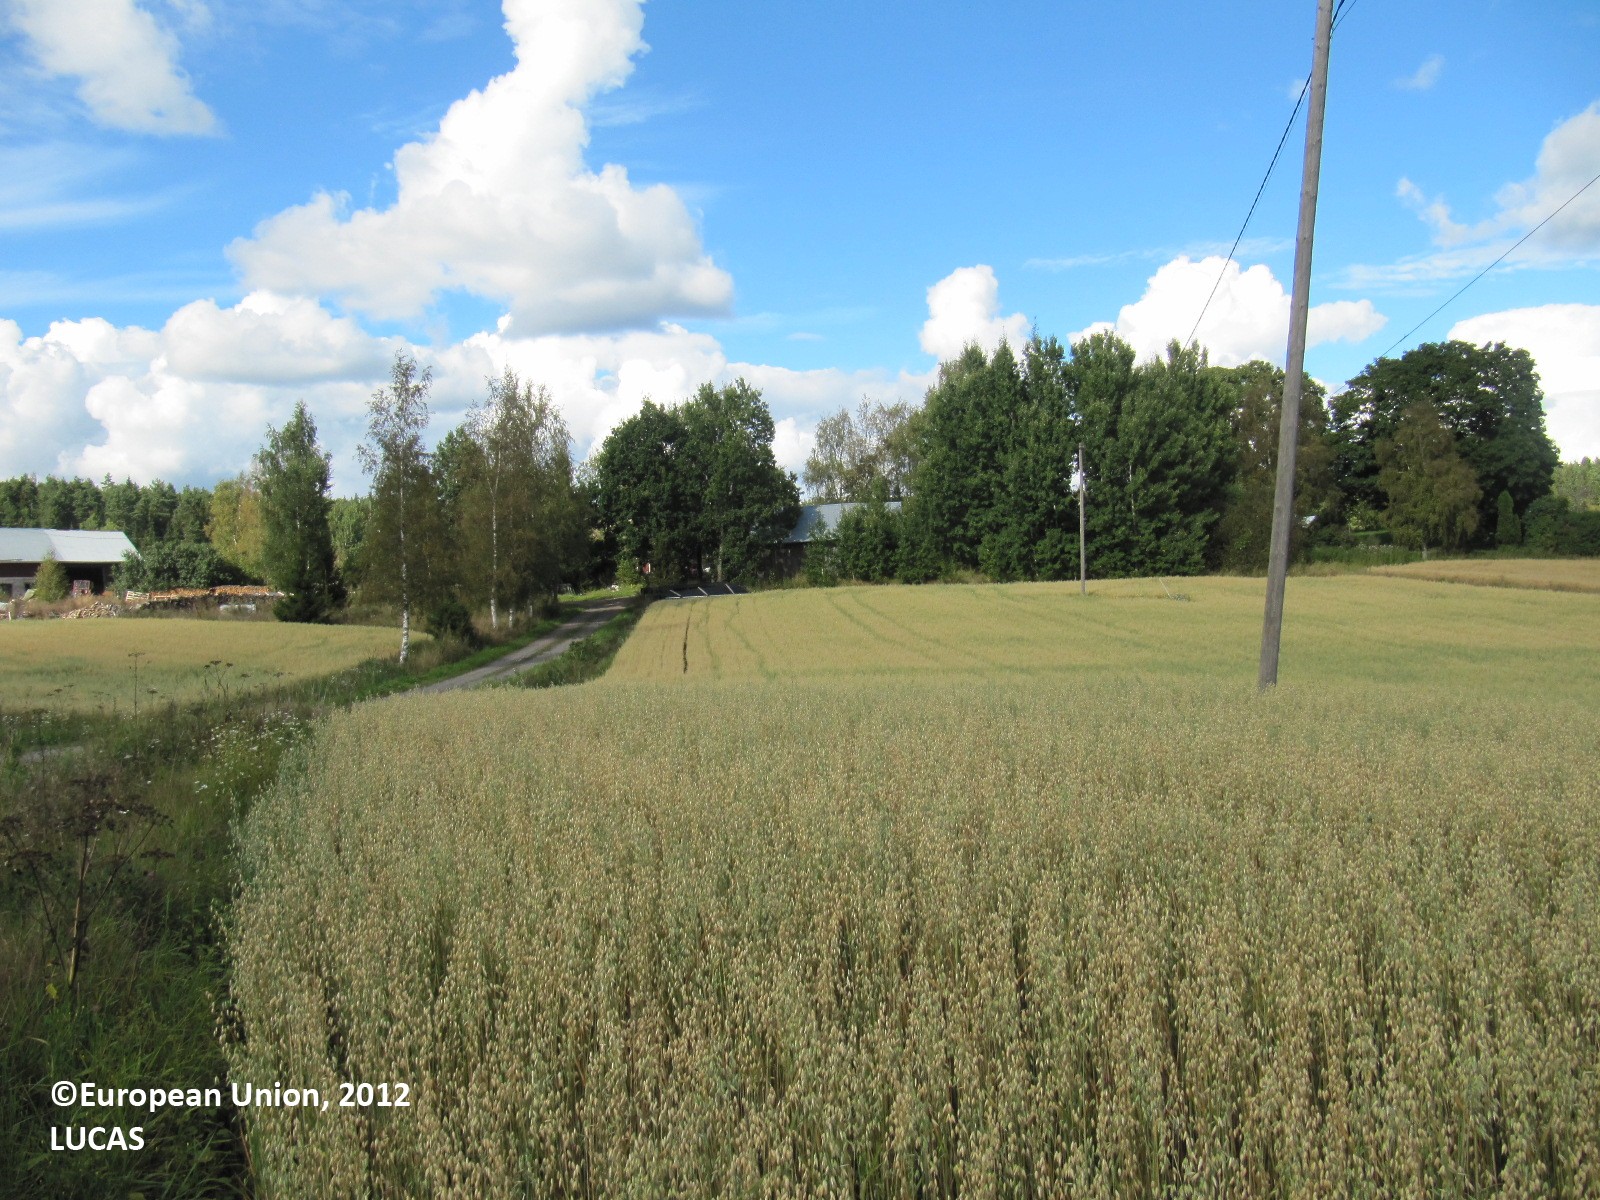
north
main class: Cropland
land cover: Oats
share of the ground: > 75 %
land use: Agriculture (excluding fallow land and kitchen gardens)
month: August
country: FI
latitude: 60.1603
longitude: 23.7692
